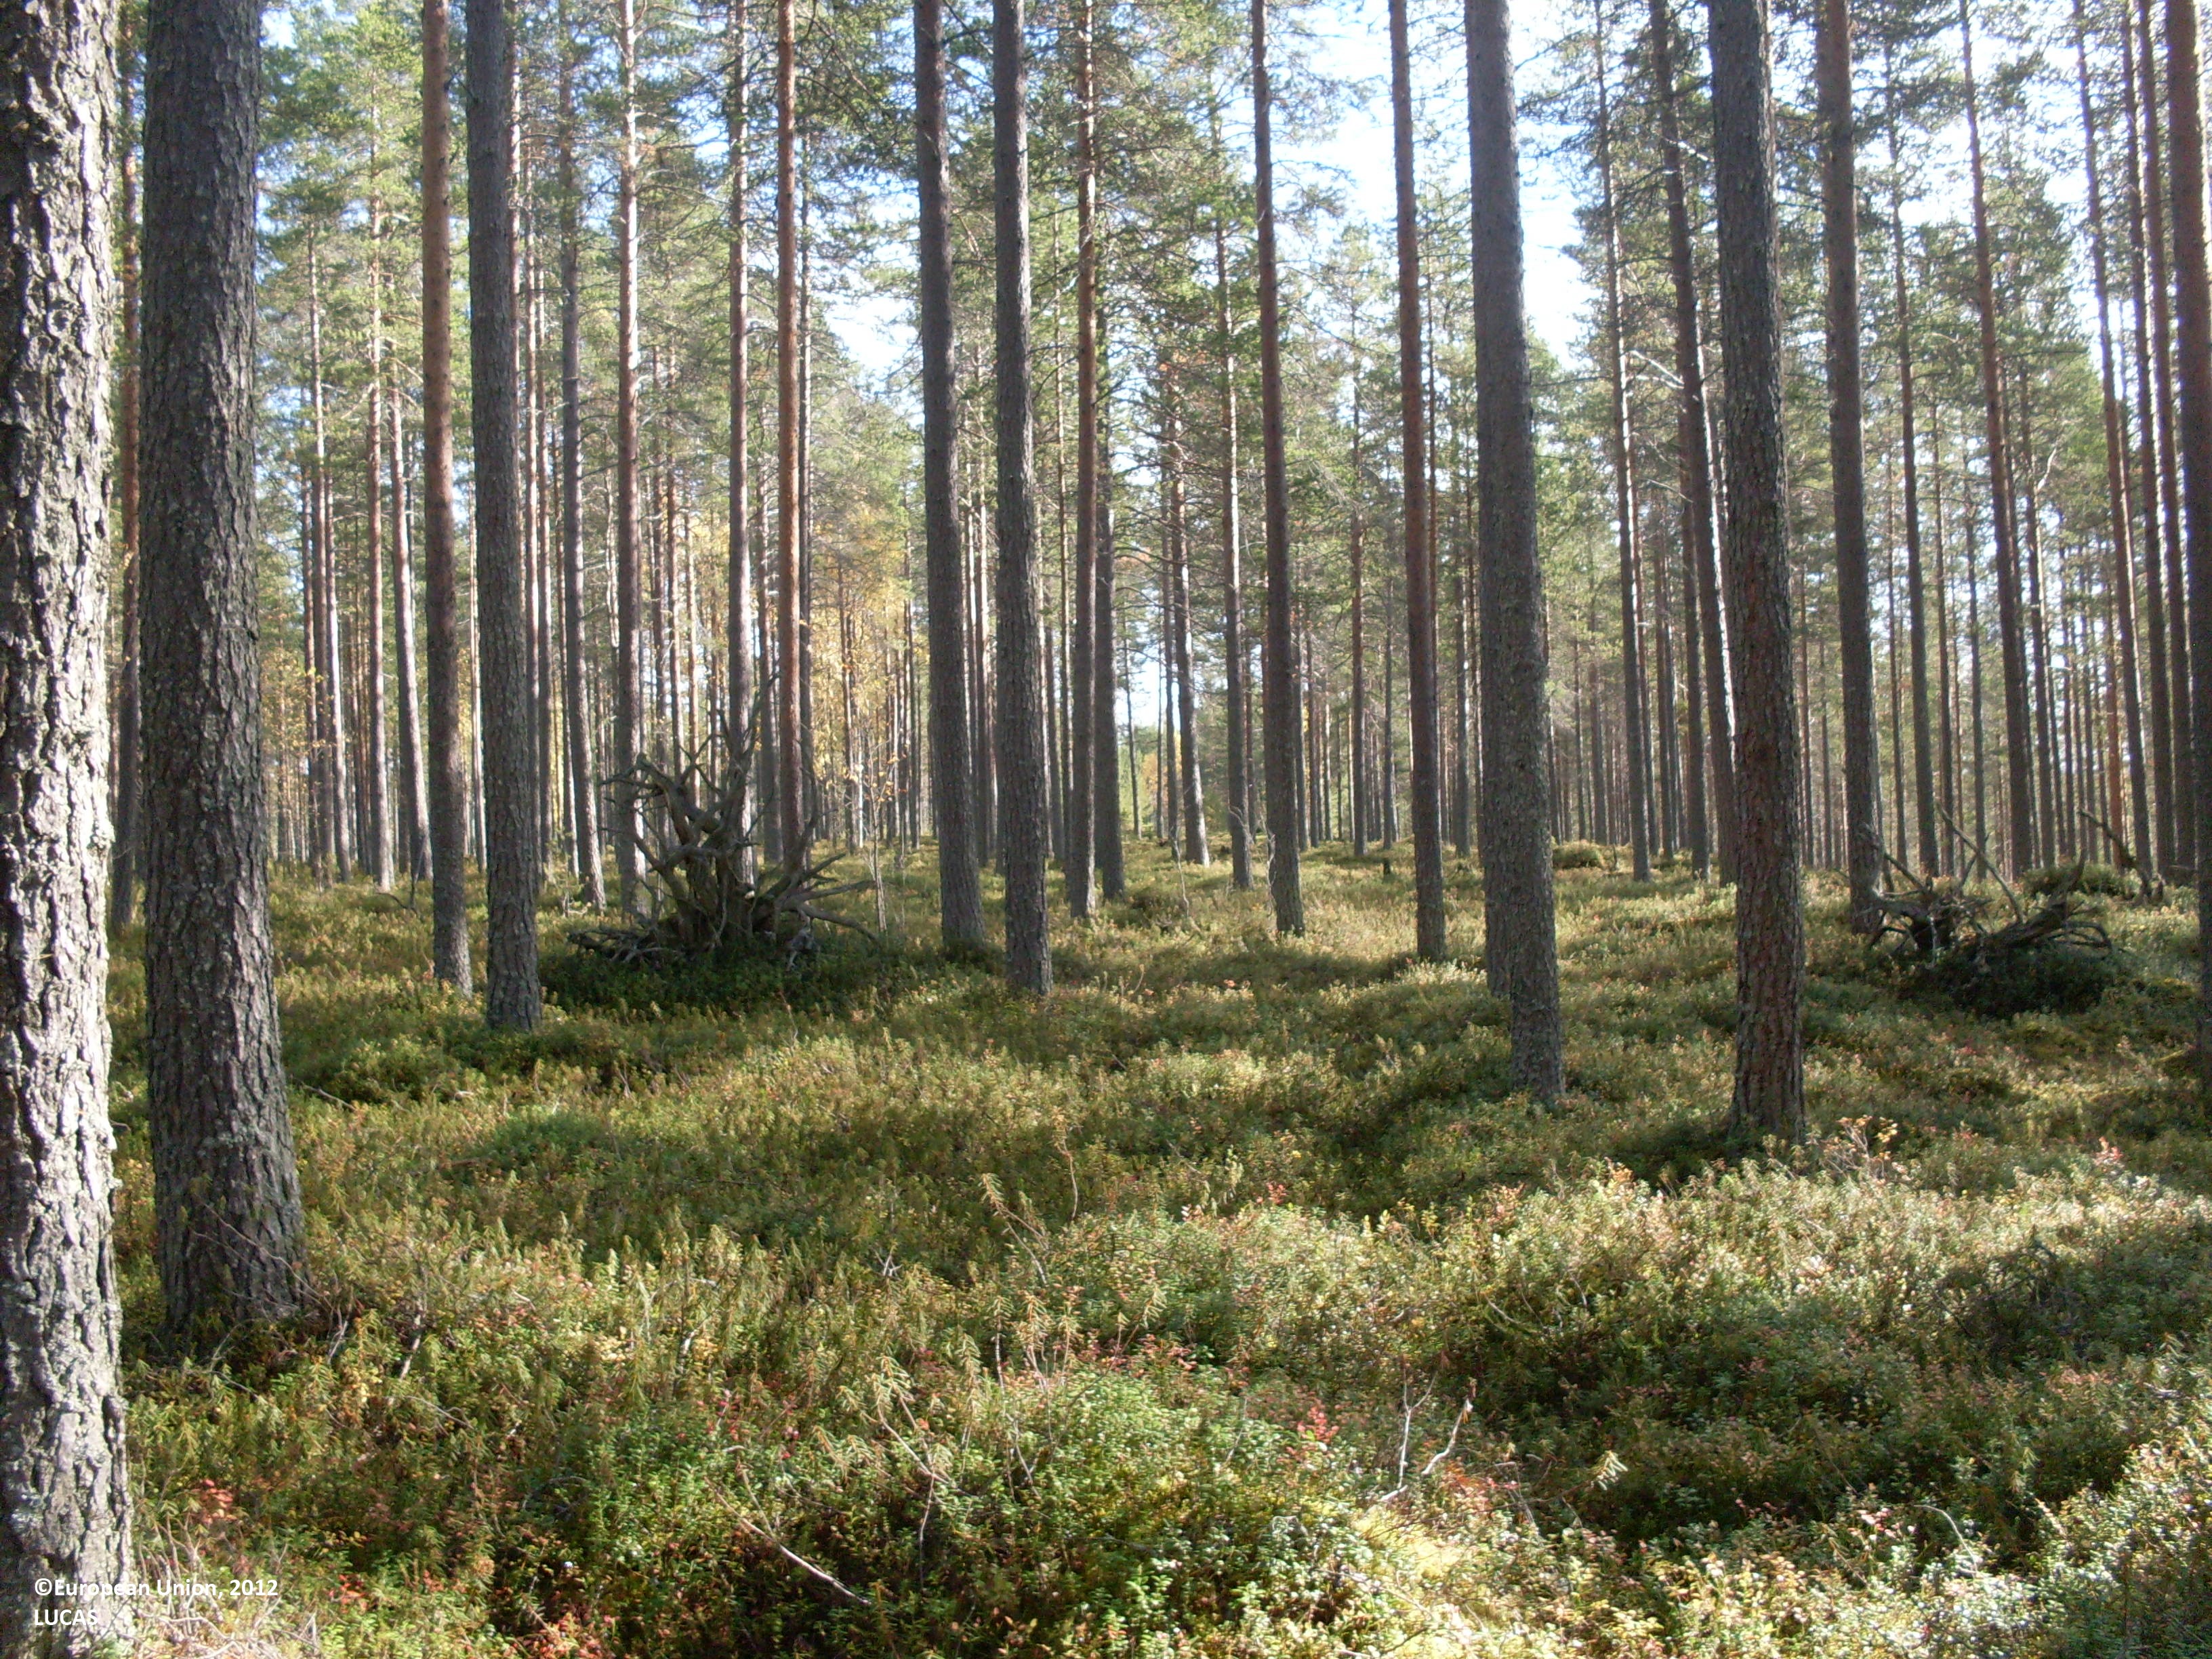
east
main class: Woodland
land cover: Pine dominated coniferous woodland
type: boreal forest
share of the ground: 50 - 75 %
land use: Forestry
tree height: > 5 m
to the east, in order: Pine dominated coniferous woodland
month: September
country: FI
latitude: 64.7439
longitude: 29.3399
